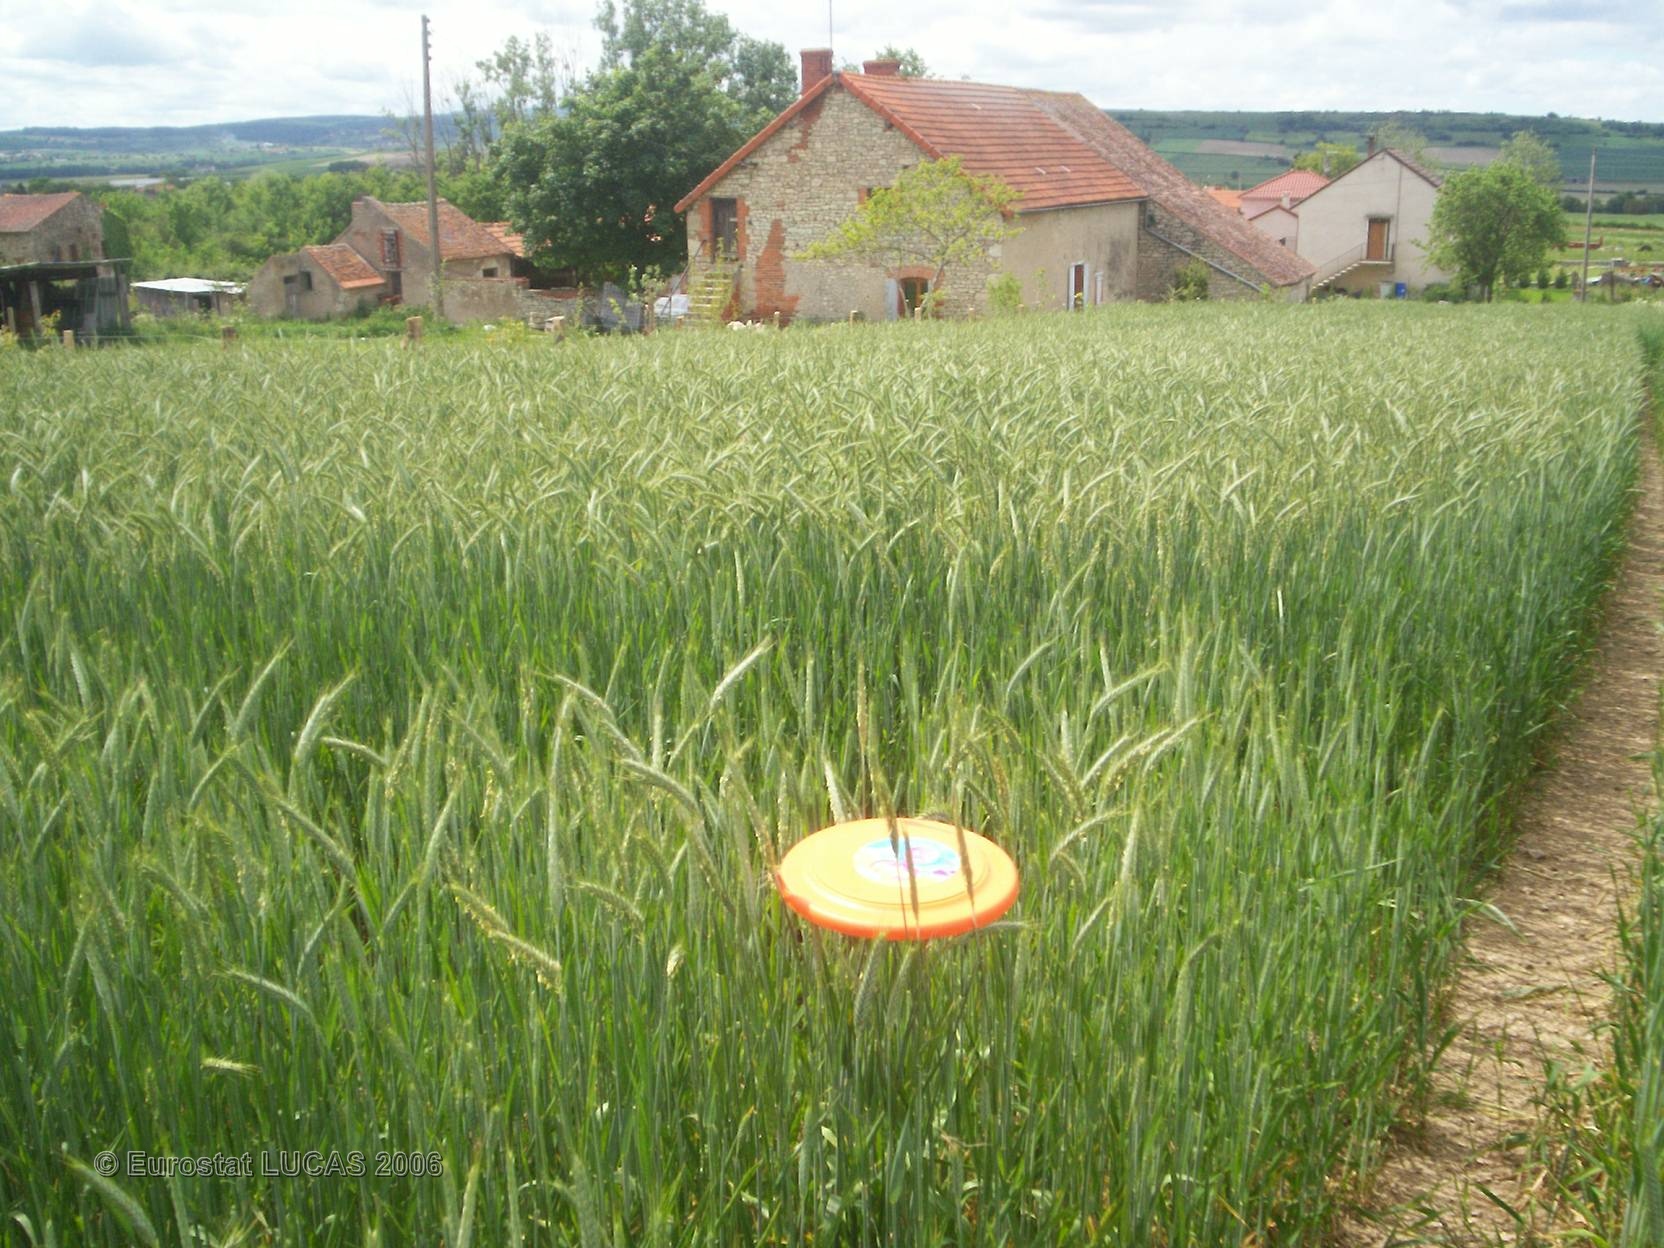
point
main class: Cropland
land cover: Triticale
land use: Agriculture (excluding fallow land and kitchen gardens)
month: May
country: FR
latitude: 46.1496
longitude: 3.1496
